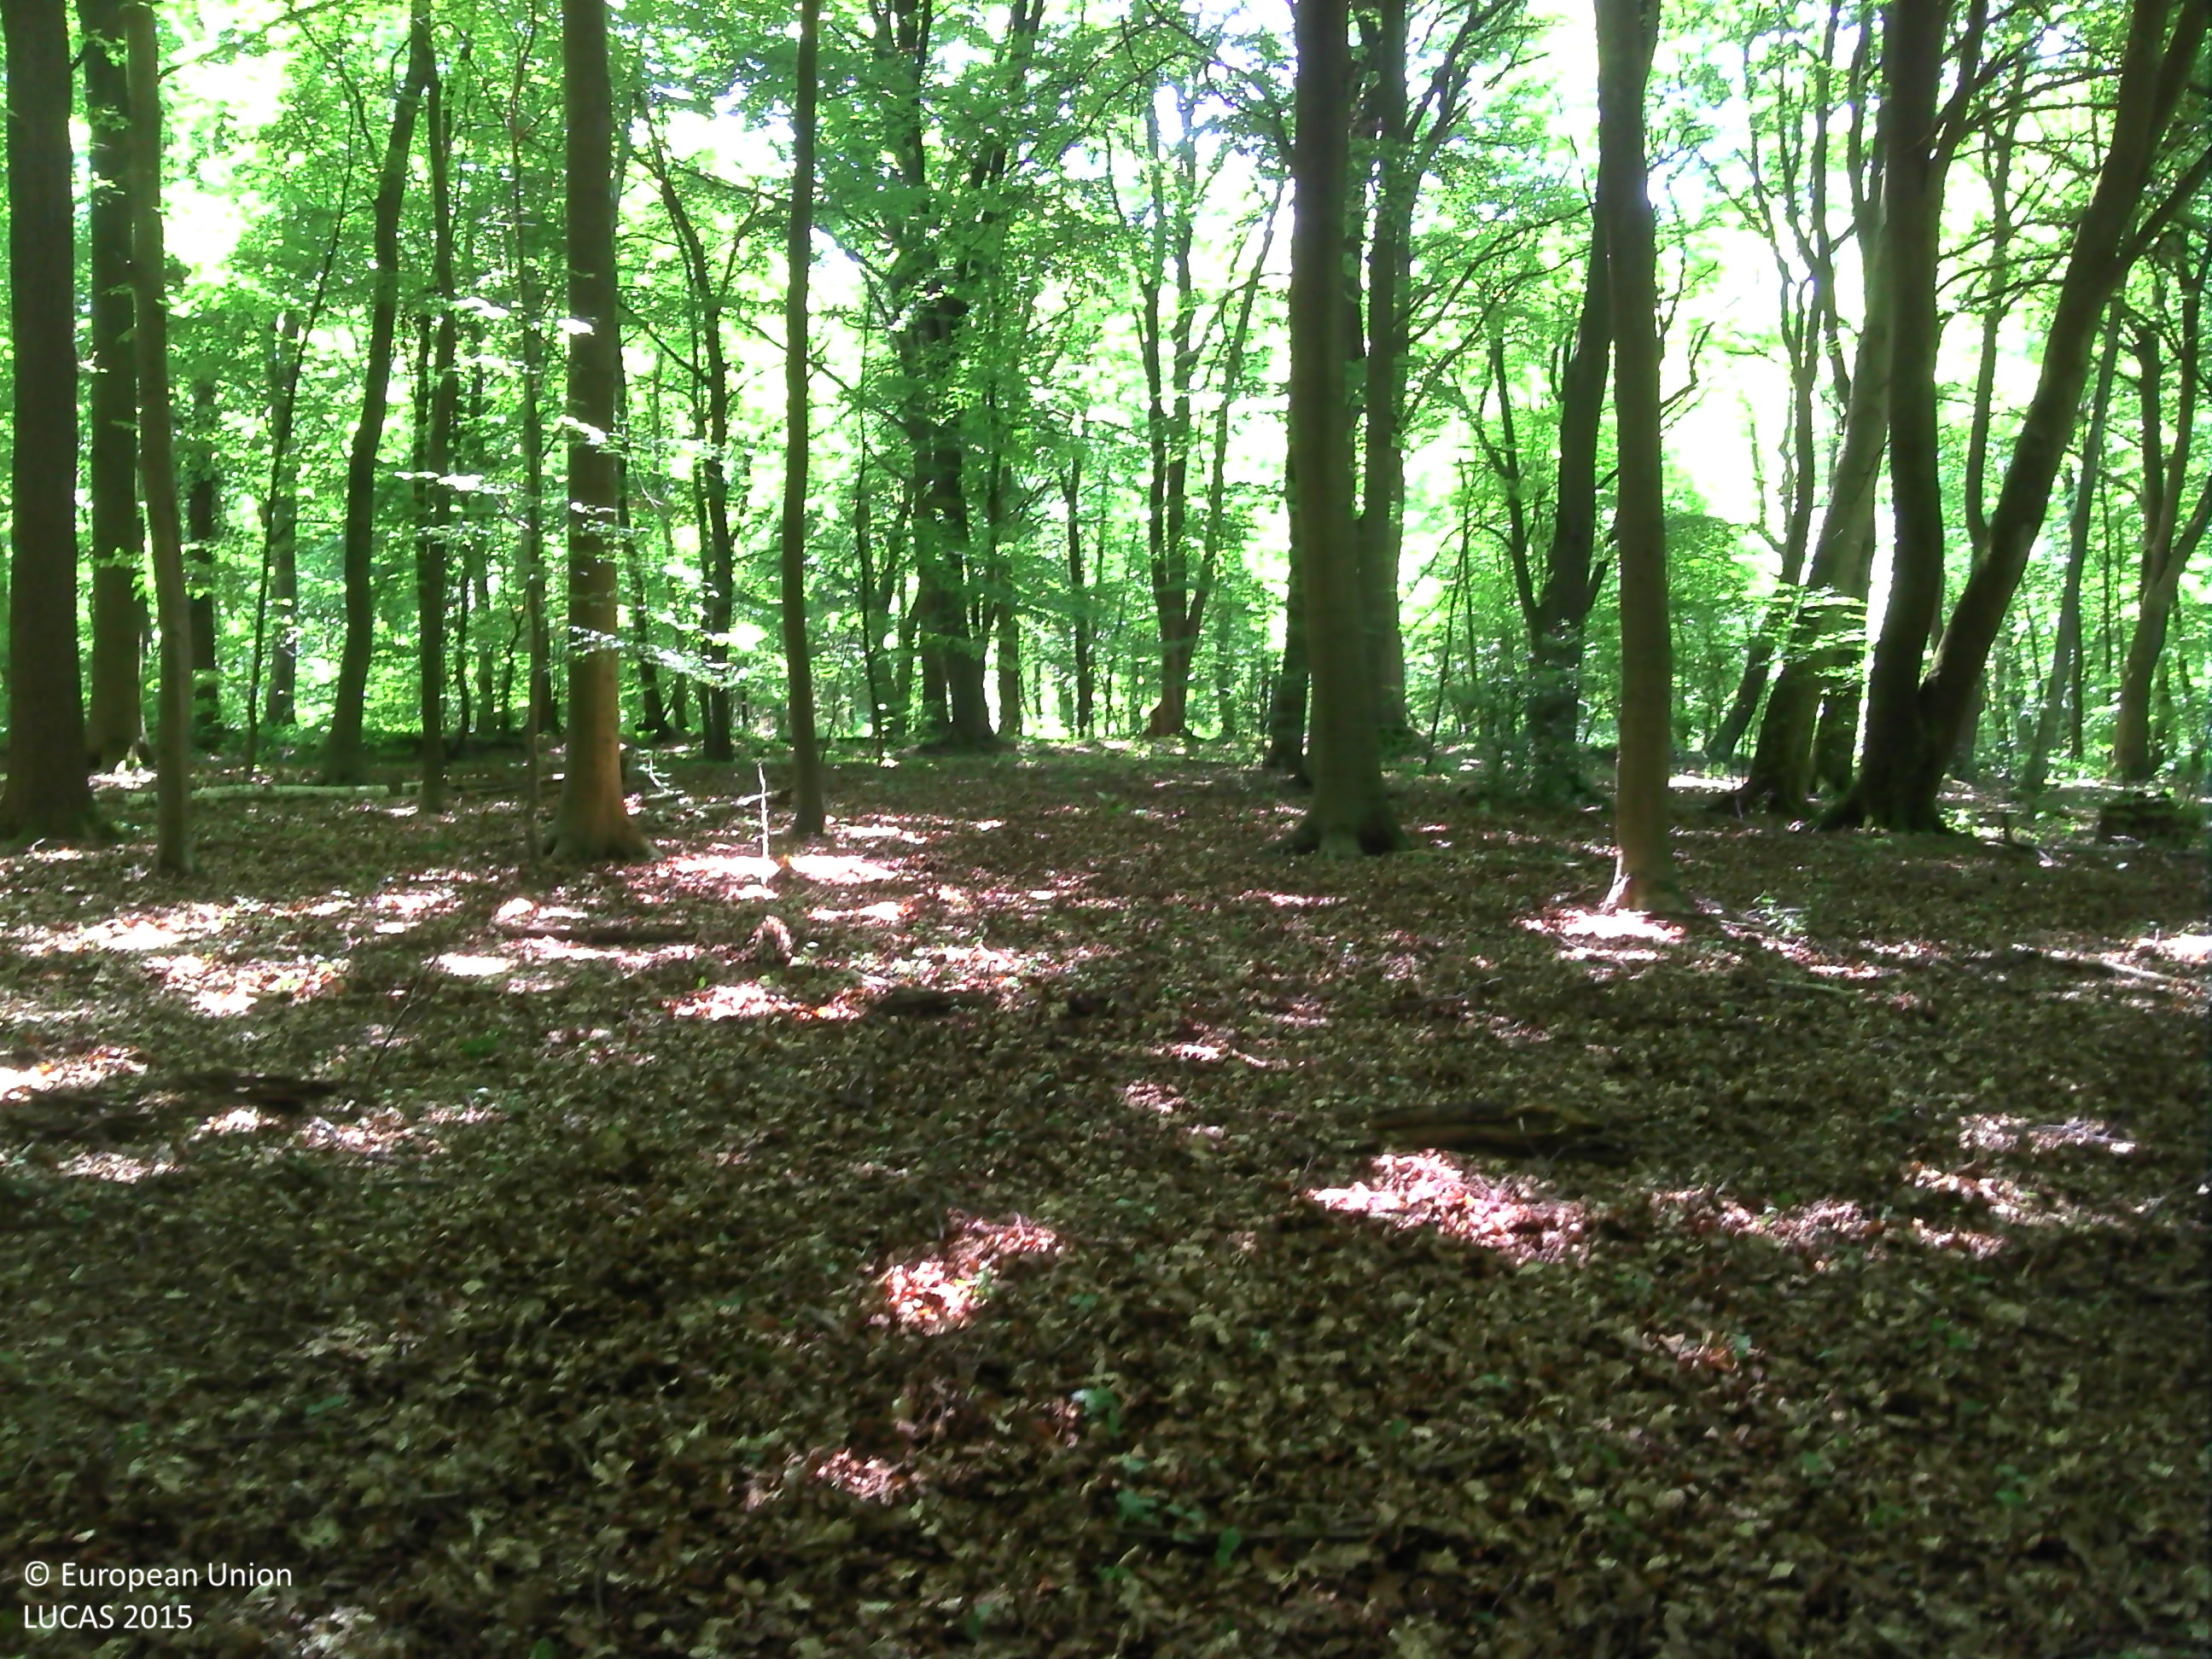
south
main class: Woodland
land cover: Broadleaved woodland
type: acidophilous oak and oak-birch forest
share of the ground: > 75 %
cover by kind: broadleaved forest trees 95 %, herbaceous plants 5 %
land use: Forestry
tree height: > 5 m
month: June
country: BE
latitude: 50.5646
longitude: 5.5229
